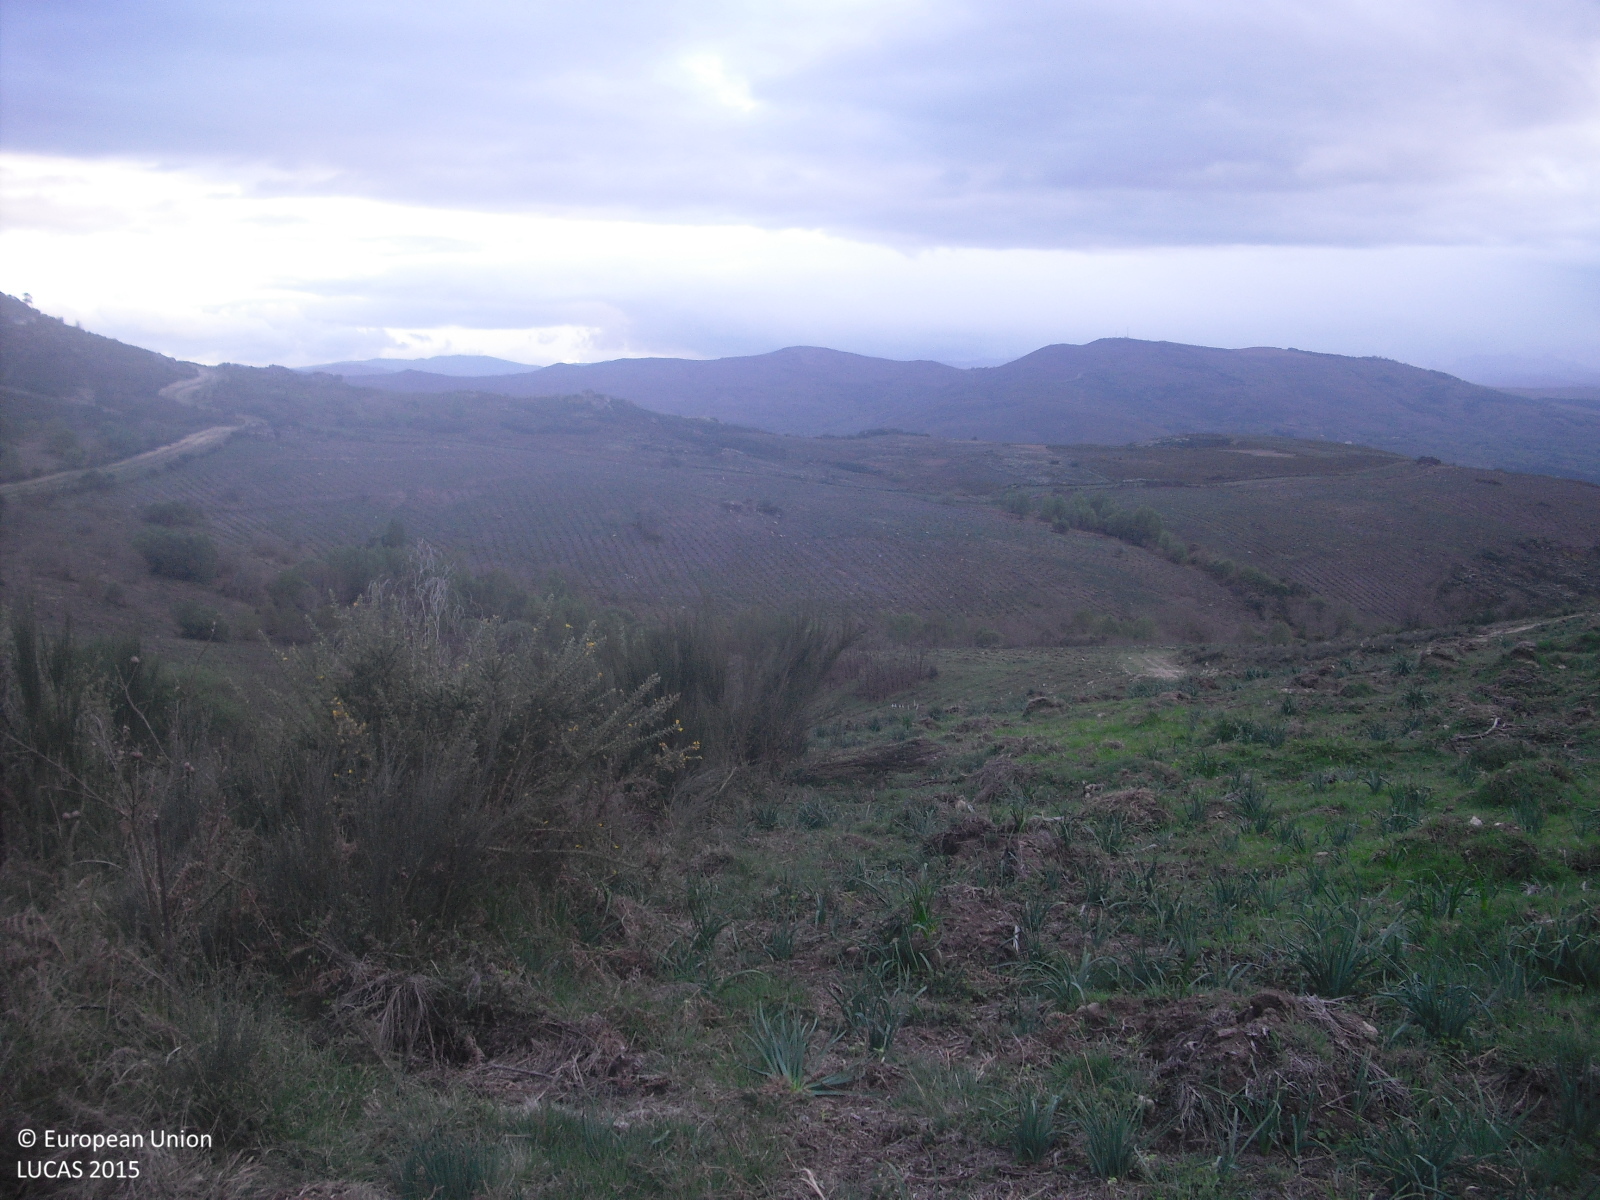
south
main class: Grassland
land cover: Grassland with sparse tree/shrub cover
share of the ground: 50 - 75 %
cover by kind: herbaceous plants 85 %, shrubs 10 %, coniferous forest trees 5 %
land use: Forestry
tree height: < 5 m
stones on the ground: < 10 %
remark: Burnt area
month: April
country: ES
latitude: 42.0418
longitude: -7.8928
